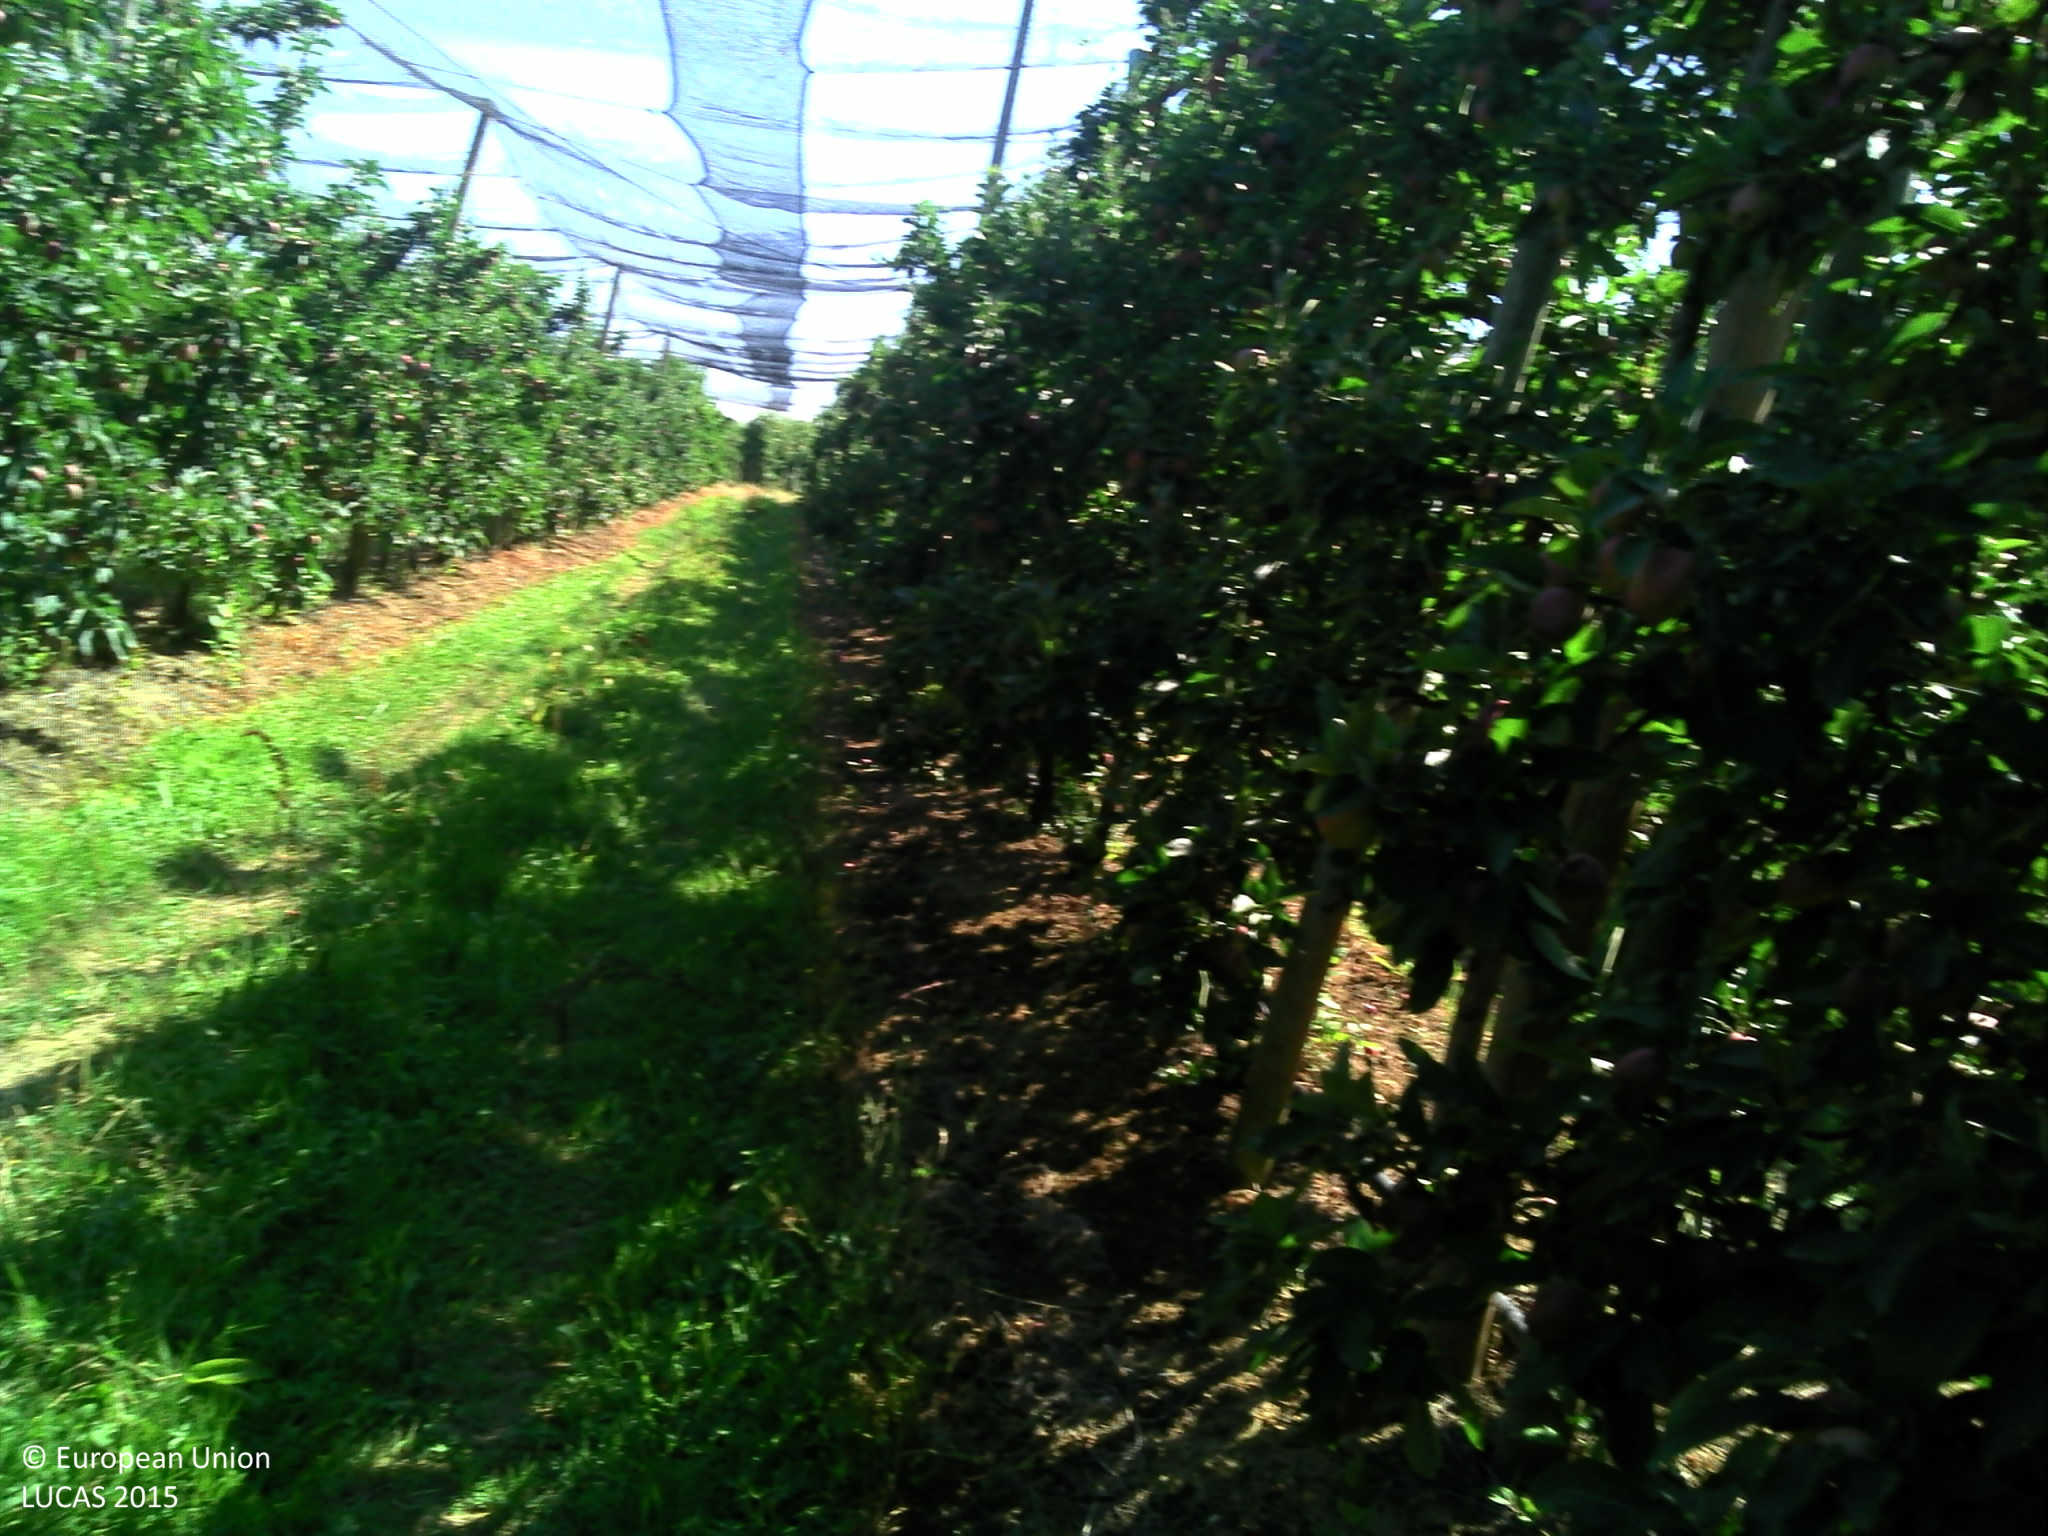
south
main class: Cropland
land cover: Apple fruit
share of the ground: 25 - 50 %
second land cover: Grassland without tree/shrub cover
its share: 25 - 50 %
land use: Agriculture (excluding fallow land and kitchen gardens)
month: July
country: FR
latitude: 44.0472
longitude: 0.9741
